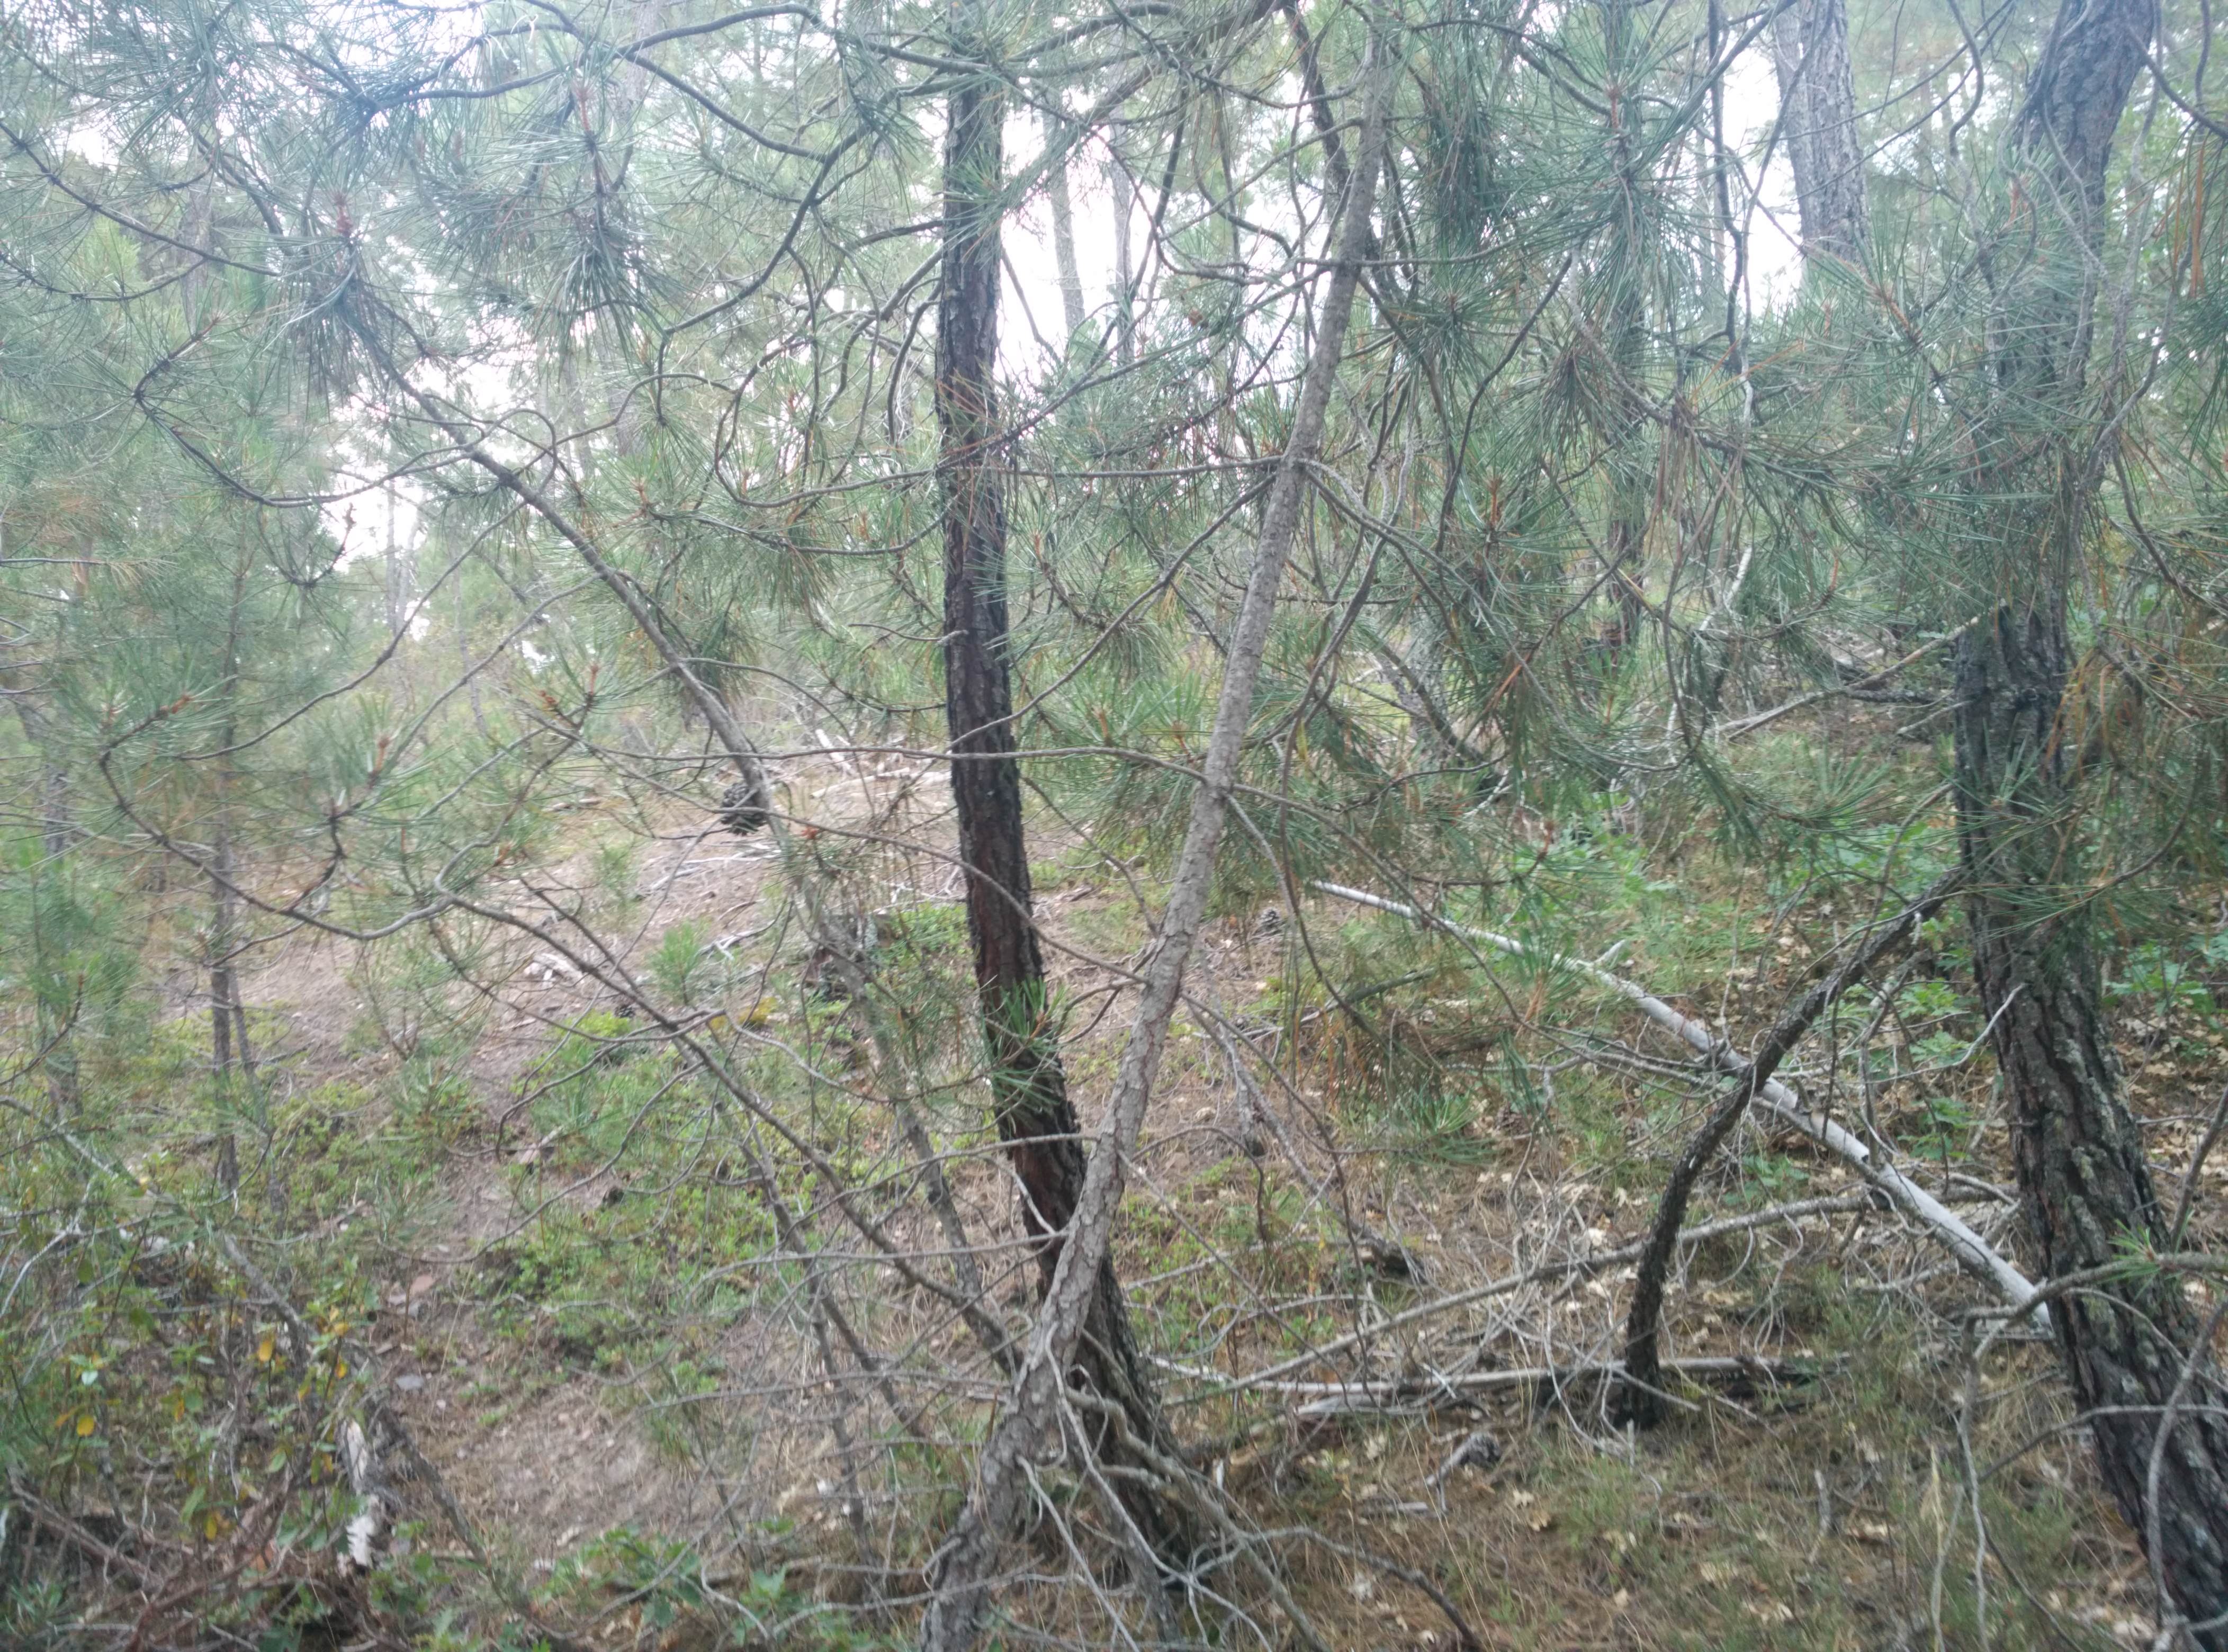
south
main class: Woodland
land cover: Pine dominated coniferous woodland
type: coniferous forest of the mediterranean region
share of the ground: 50 - 75 %
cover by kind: coniferous forest trees 70 %, shrubs 20 %, unconsolidated bare surface 10 %
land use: Semi-natural and natural areas not in use
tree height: > 5 m
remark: Clear cut
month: July
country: ES
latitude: 40.8591
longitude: -2.0174
